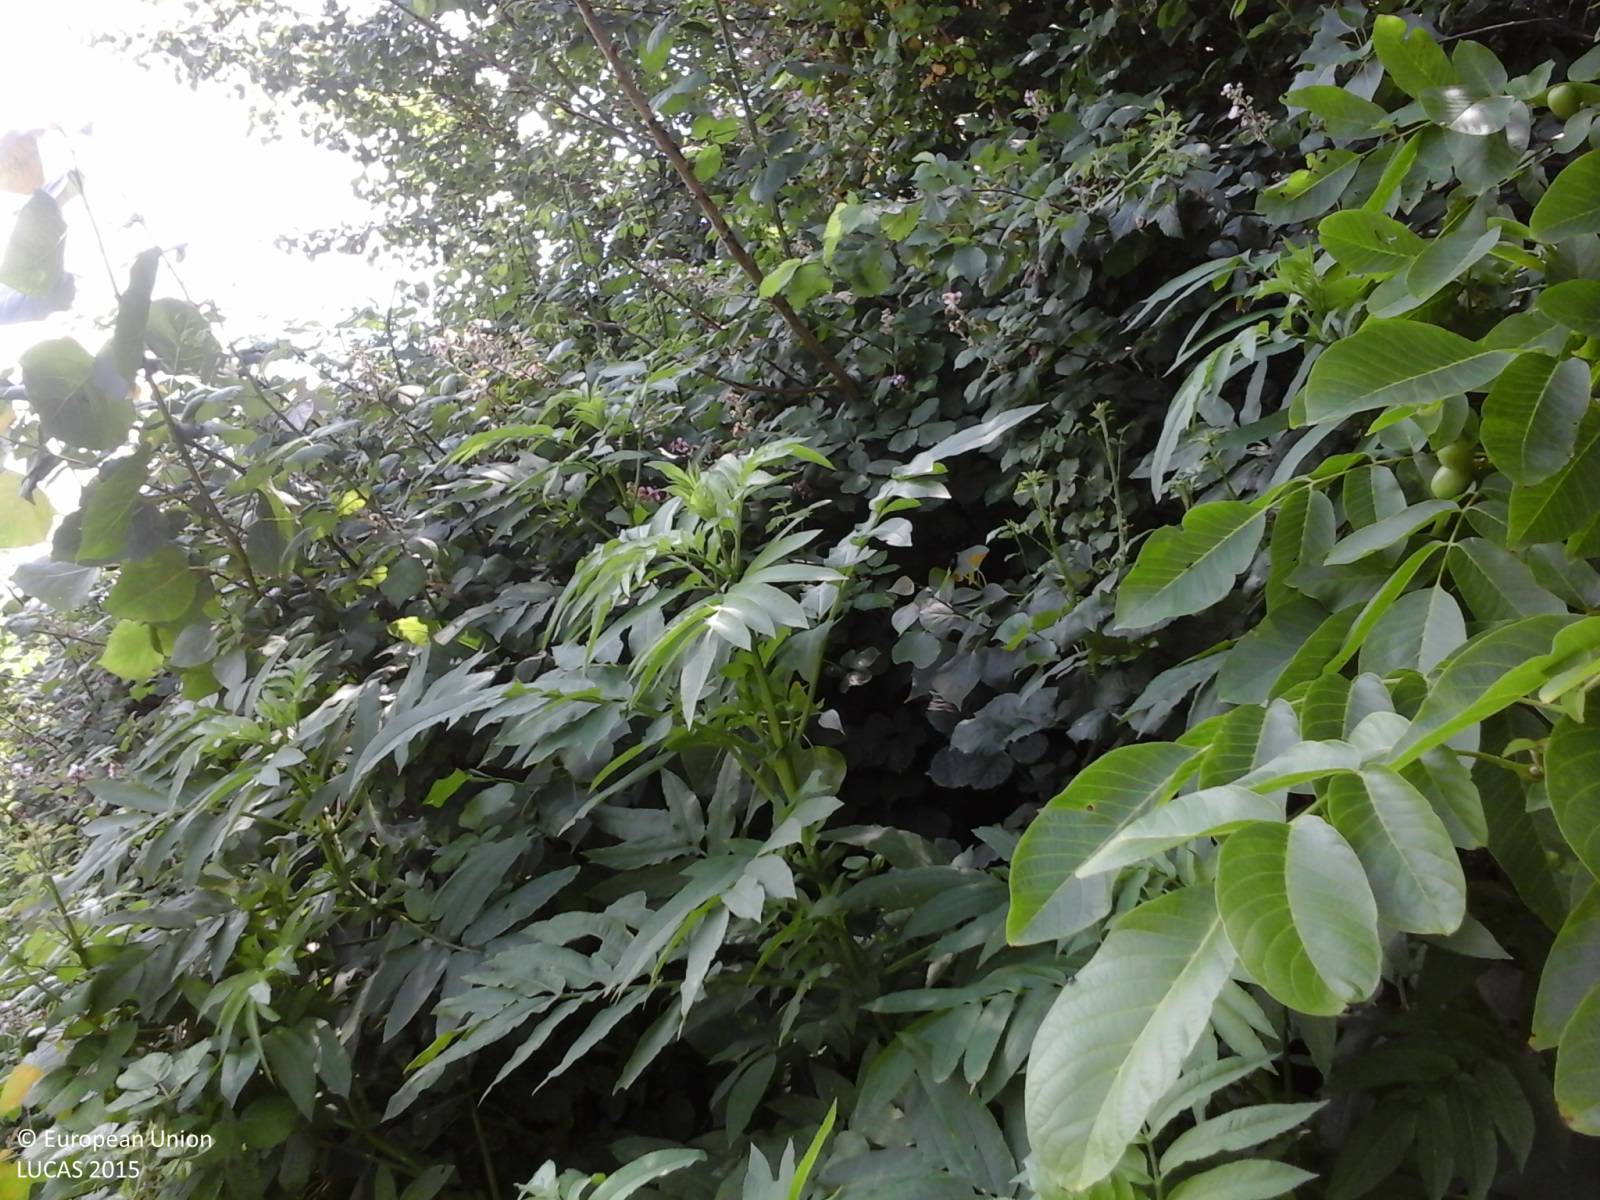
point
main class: Woodland
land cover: Broadleaved woodland
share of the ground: > 75 %
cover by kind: broadleaved forest trees 100 %
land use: Semi-natural and natural areas not in use
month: June
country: IT
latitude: 41.0266
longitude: 14.2525
